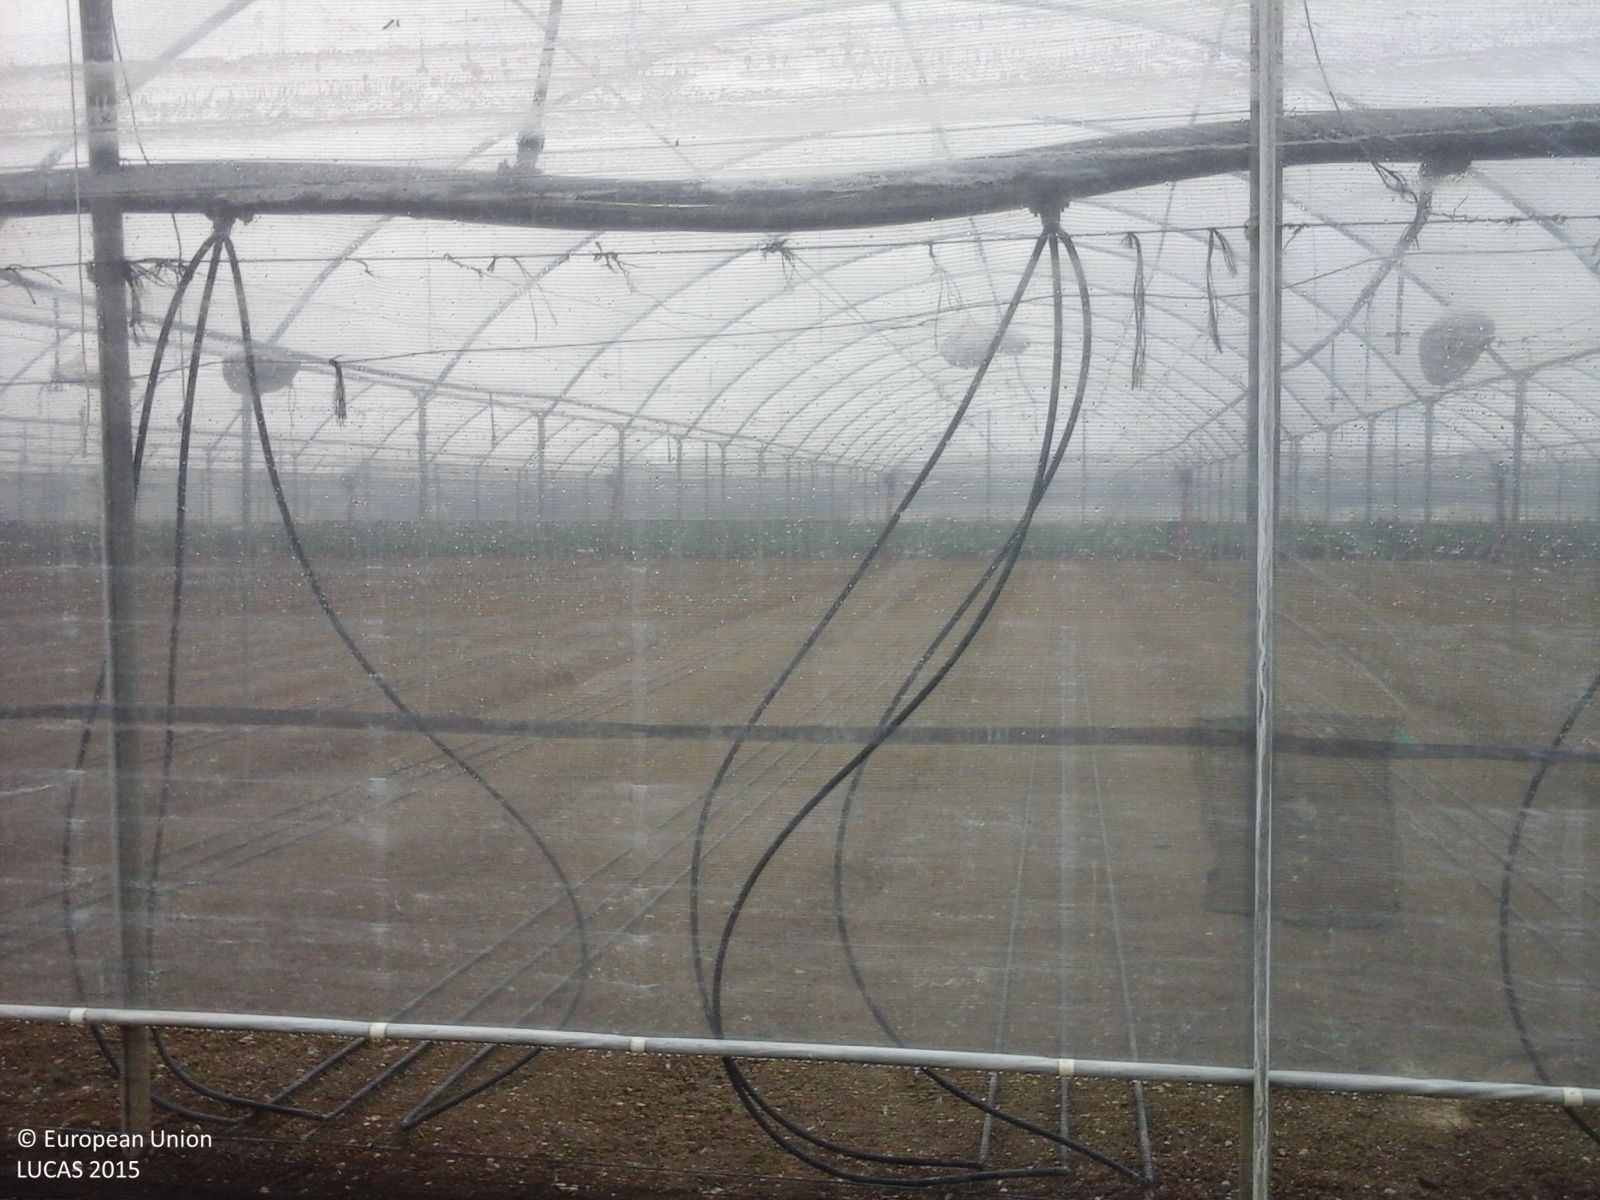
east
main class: Artificial land
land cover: Greenhouses
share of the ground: > 75 %
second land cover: Other fresh vegetables
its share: > 75 %
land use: Agriculture (excluding fallow land and kitchen gardens)
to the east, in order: Artificial constructions in urban areas; Other fresh vegetables
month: May
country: IT
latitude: 40.5725
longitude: 15.0465
